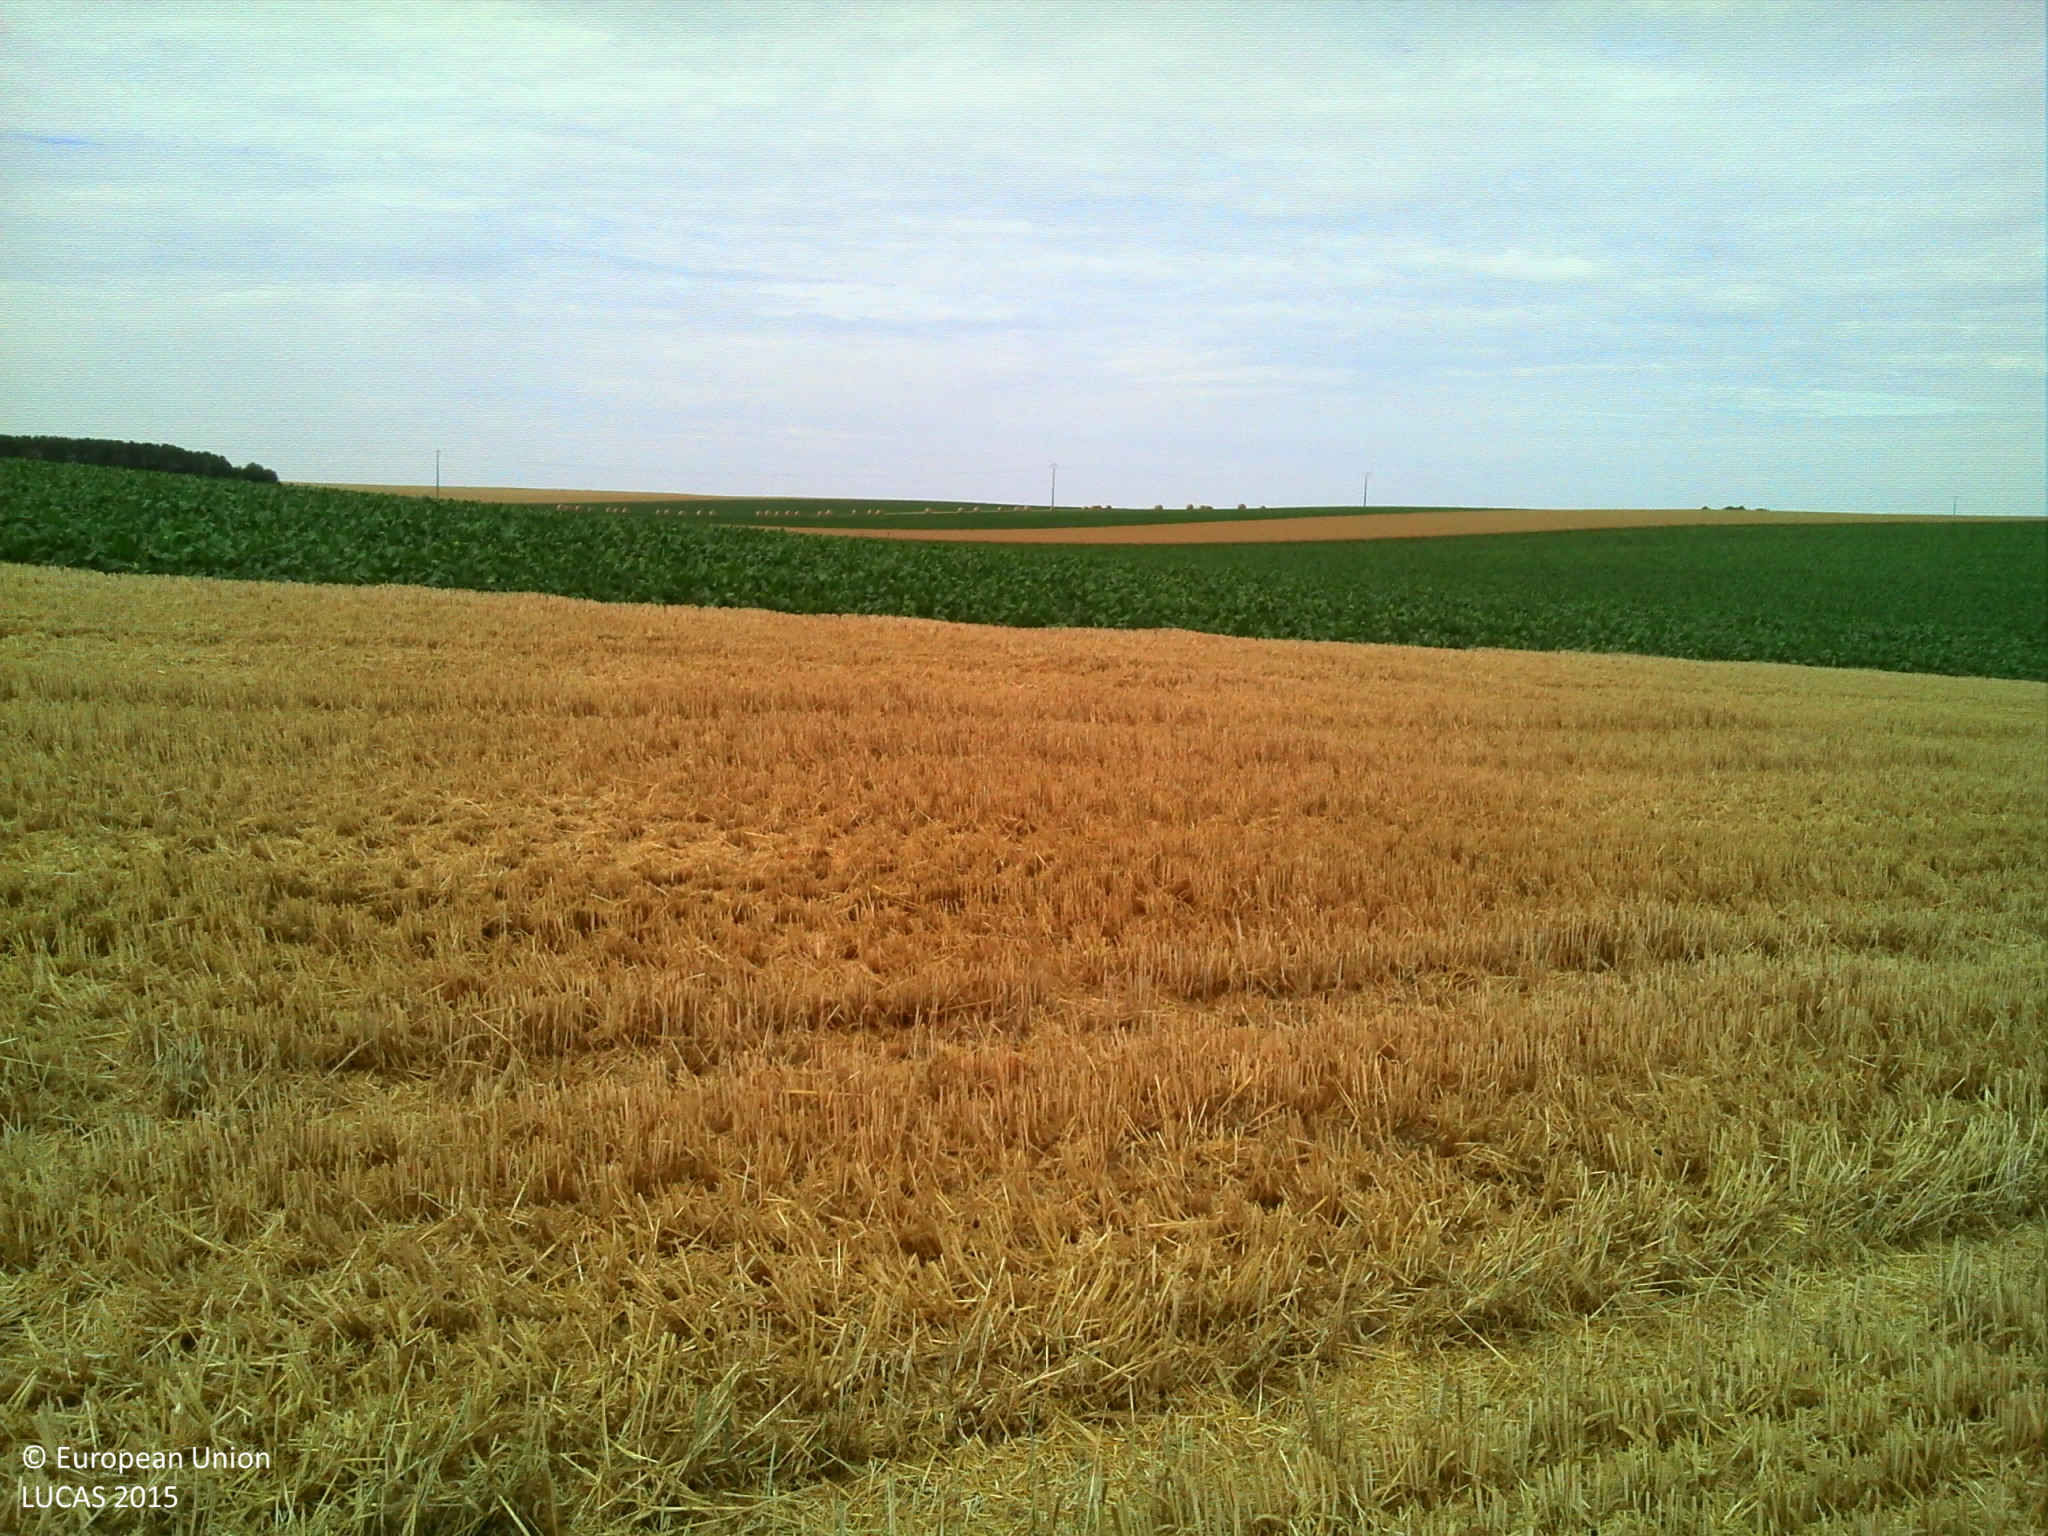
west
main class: Cropland
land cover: Barley
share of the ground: > 75 %
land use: Agriculture (excluding fallow land and kitchen gardens)
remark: Harvested field
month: July
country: FR
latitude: 49.2604
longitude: 4.5414
